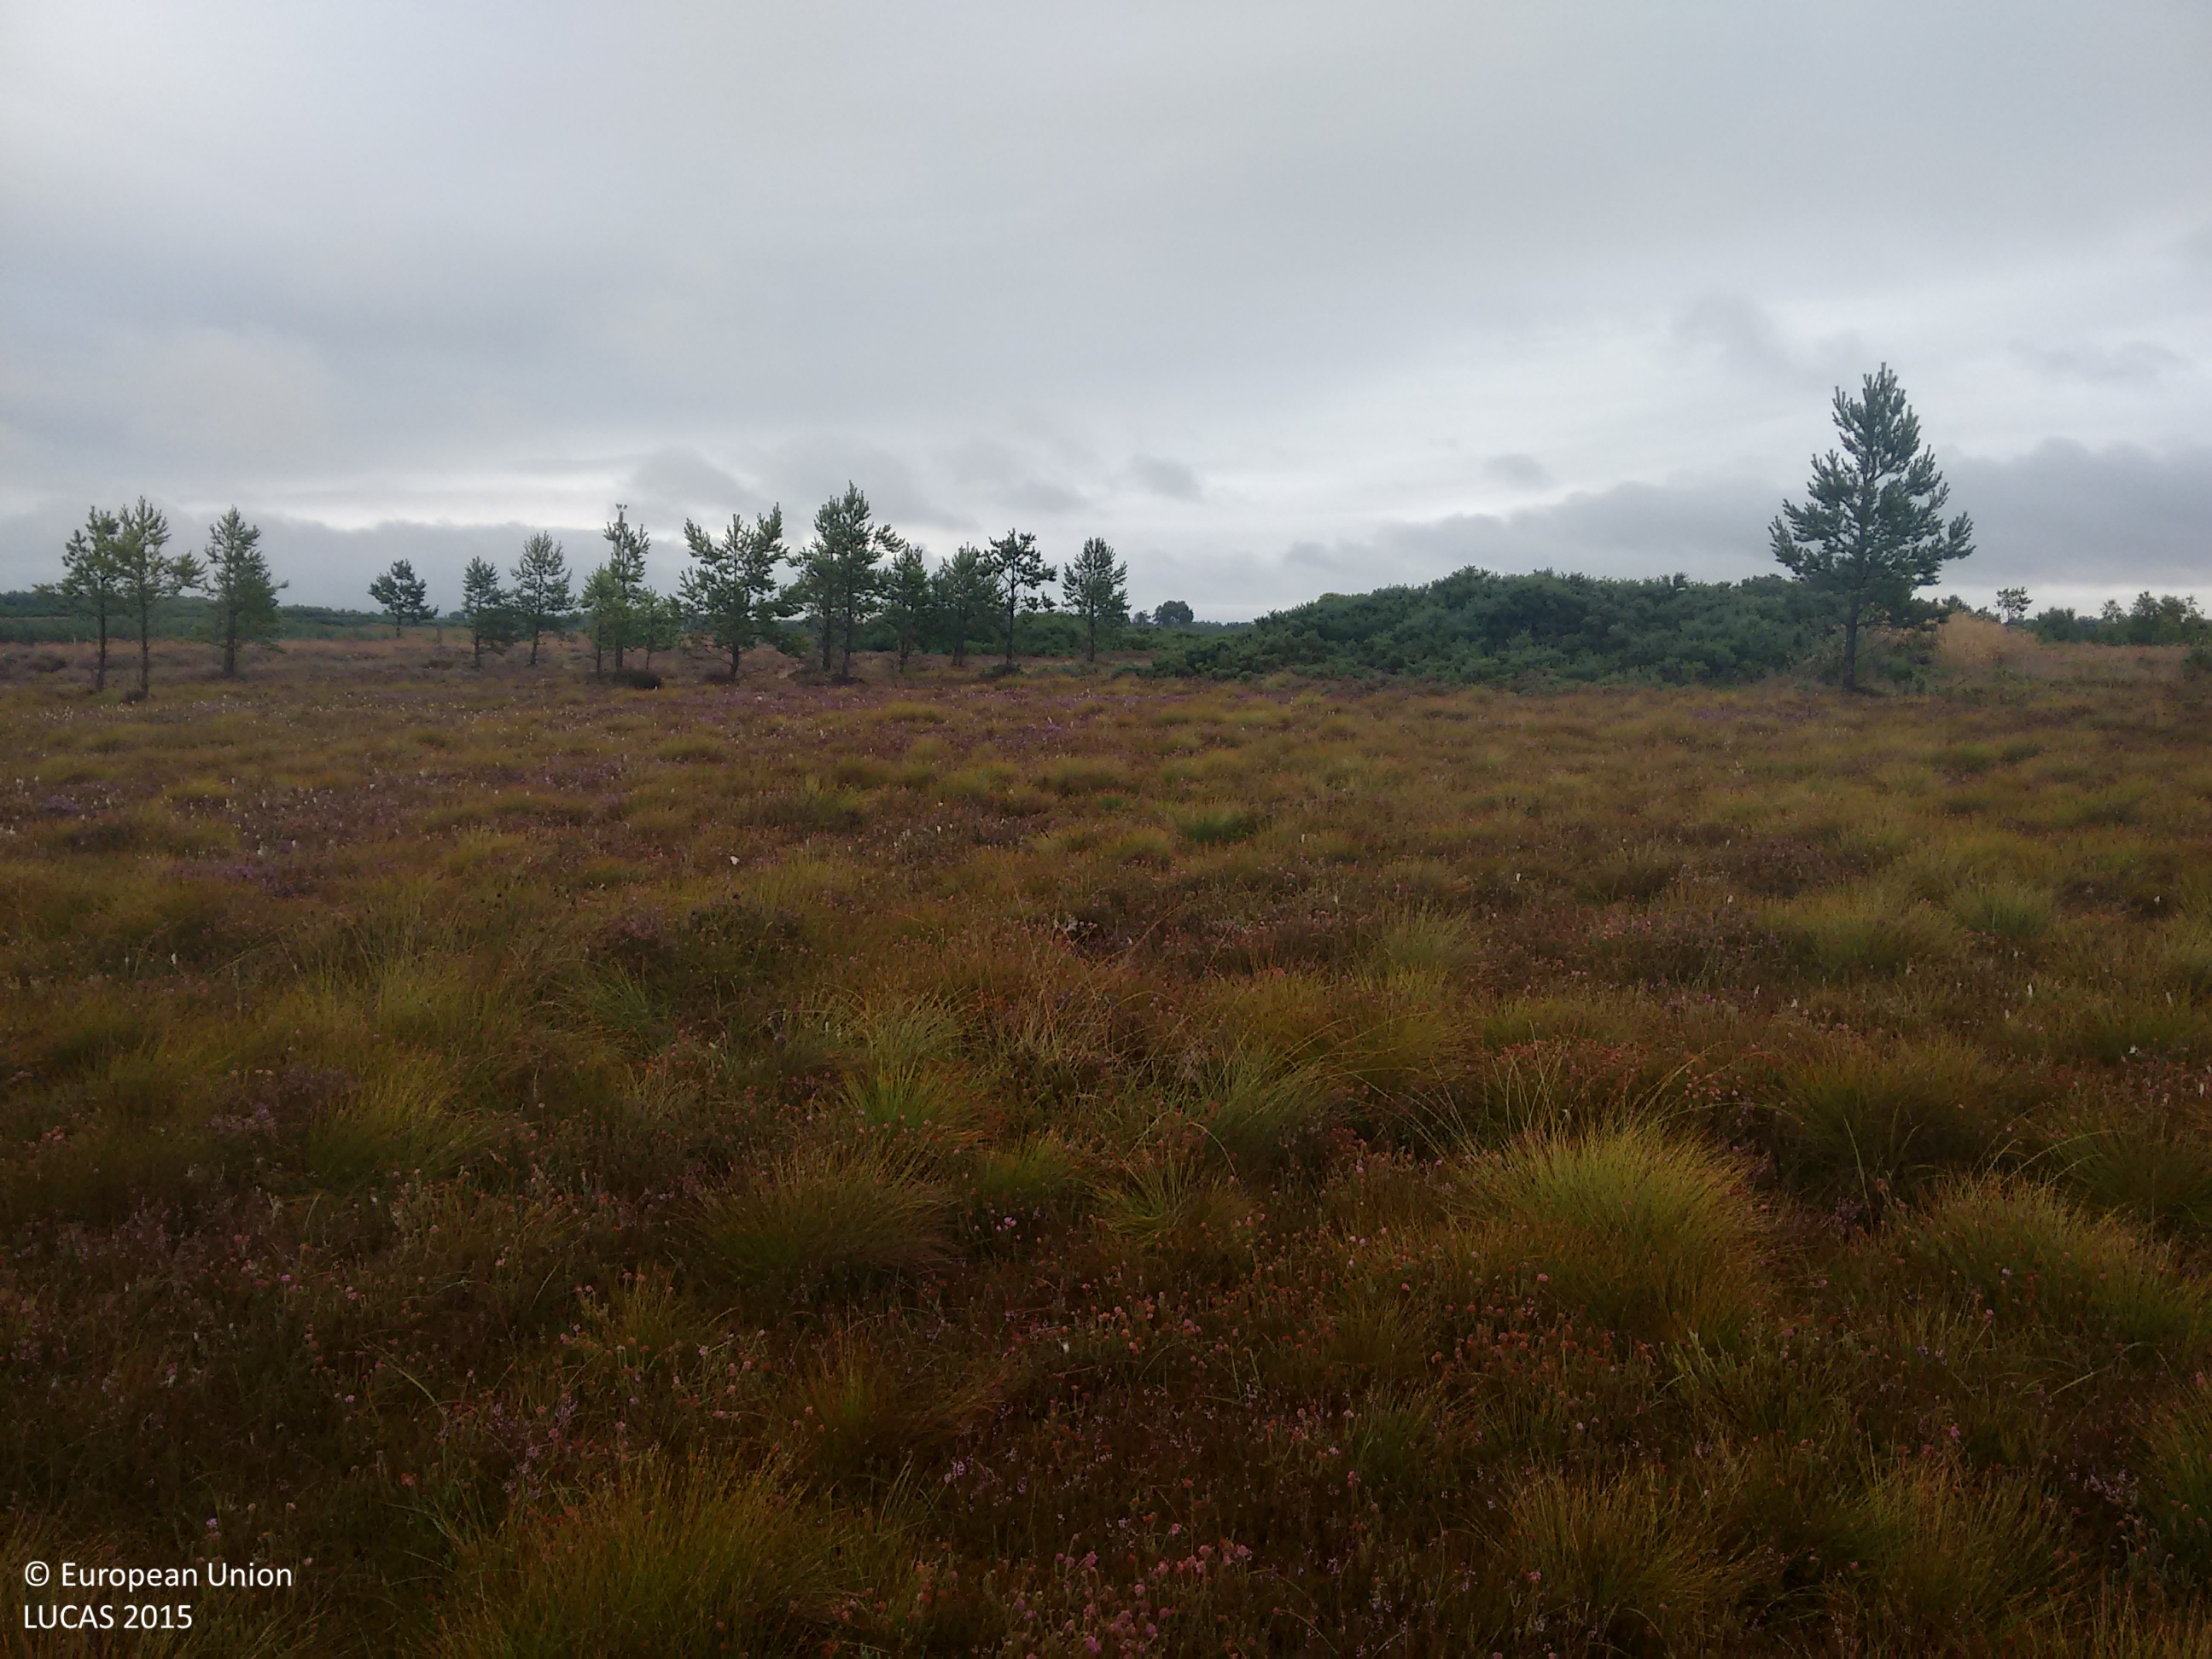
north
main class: Shrubland
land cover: Shrubland without tree cover
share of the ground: > 75 %
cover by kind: shrubs 55 %, herbaceous plants 40 %, lichens and mosses 5 %
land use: Semi-natural and natural areas not in use
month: August
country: GB
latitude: 57.7937
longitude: -3.9908
